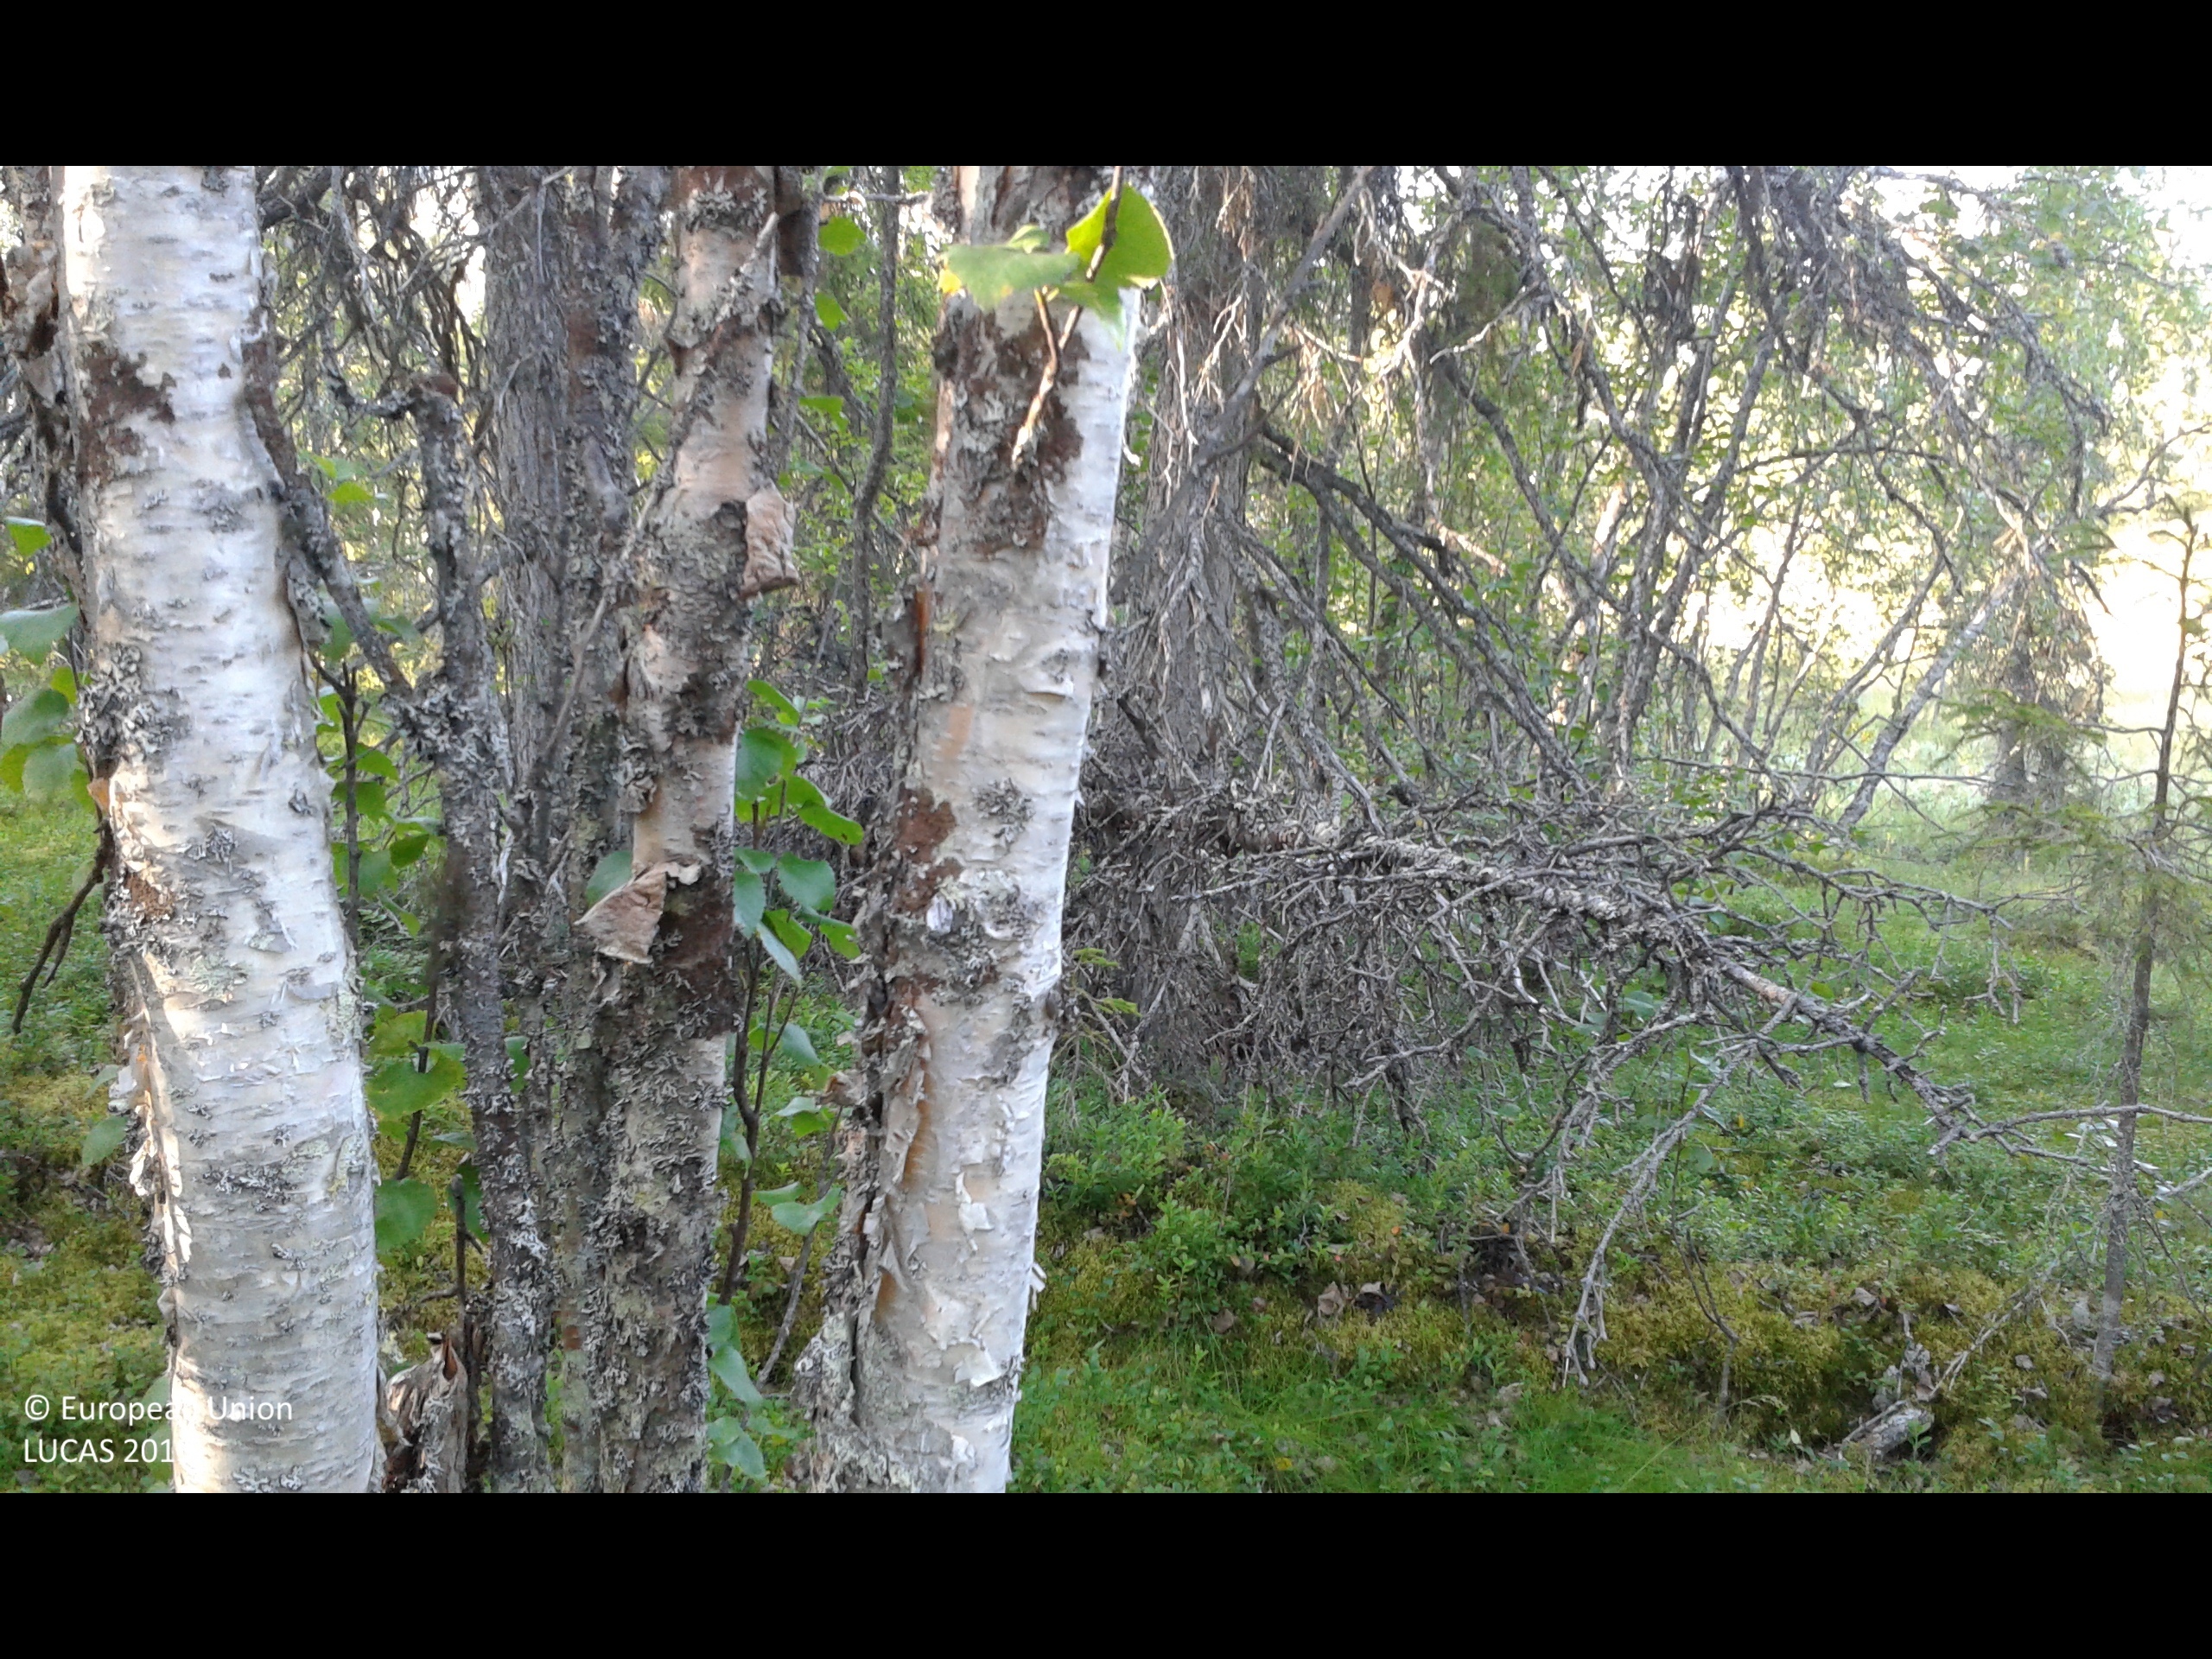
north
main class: Woodland
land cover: Spruce dominated mixed woodland
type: boreal forest
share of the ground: 25 - 50 %
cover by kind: shrubs 50 %, coniferous forest trees 25 %, lichens and mosses 15 %, broadleaved forest trees 10 %
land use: Forestry
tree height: > 5 m
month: August
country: SE
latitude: 67.3158
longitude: 21.1731
